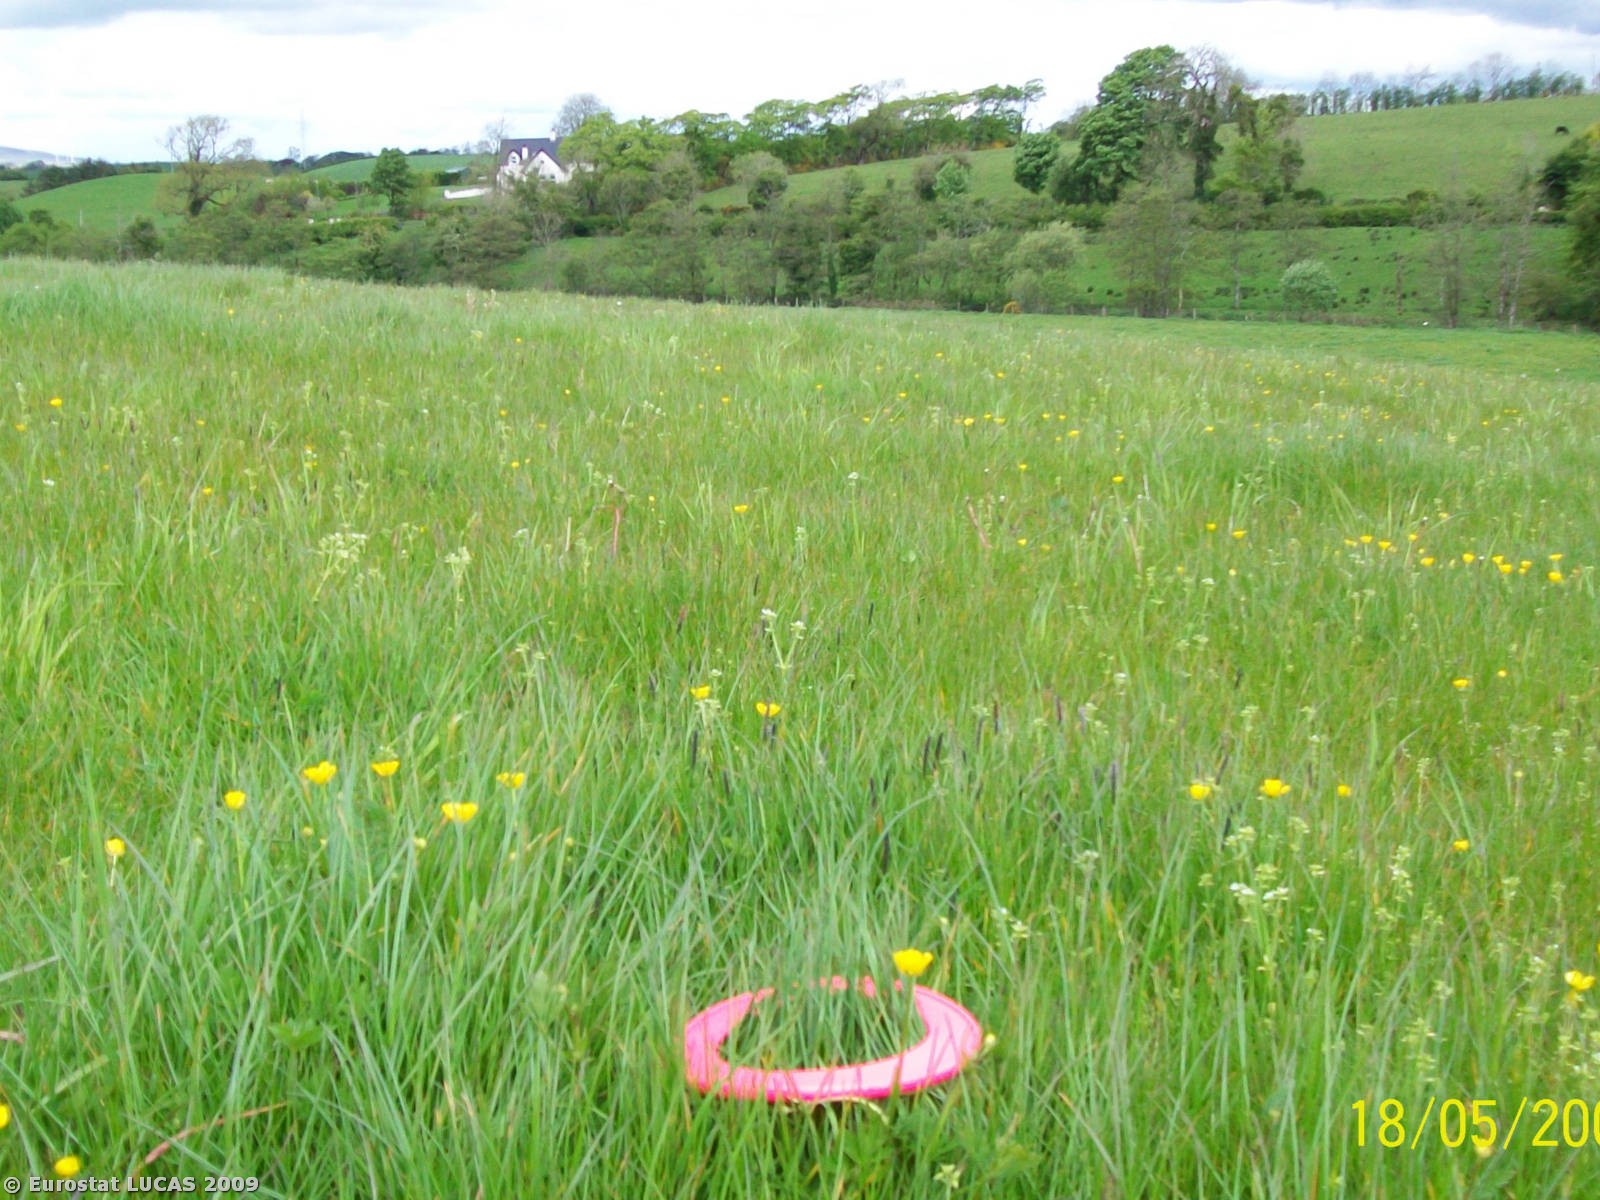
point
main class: Grassland
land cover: Grassland without tree/shrub cover
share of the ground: > 75 %
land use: Agriculture (excluding fallow land and kitchen gardens)
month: May
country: GB
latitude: 54.5523
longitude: -7.3272
